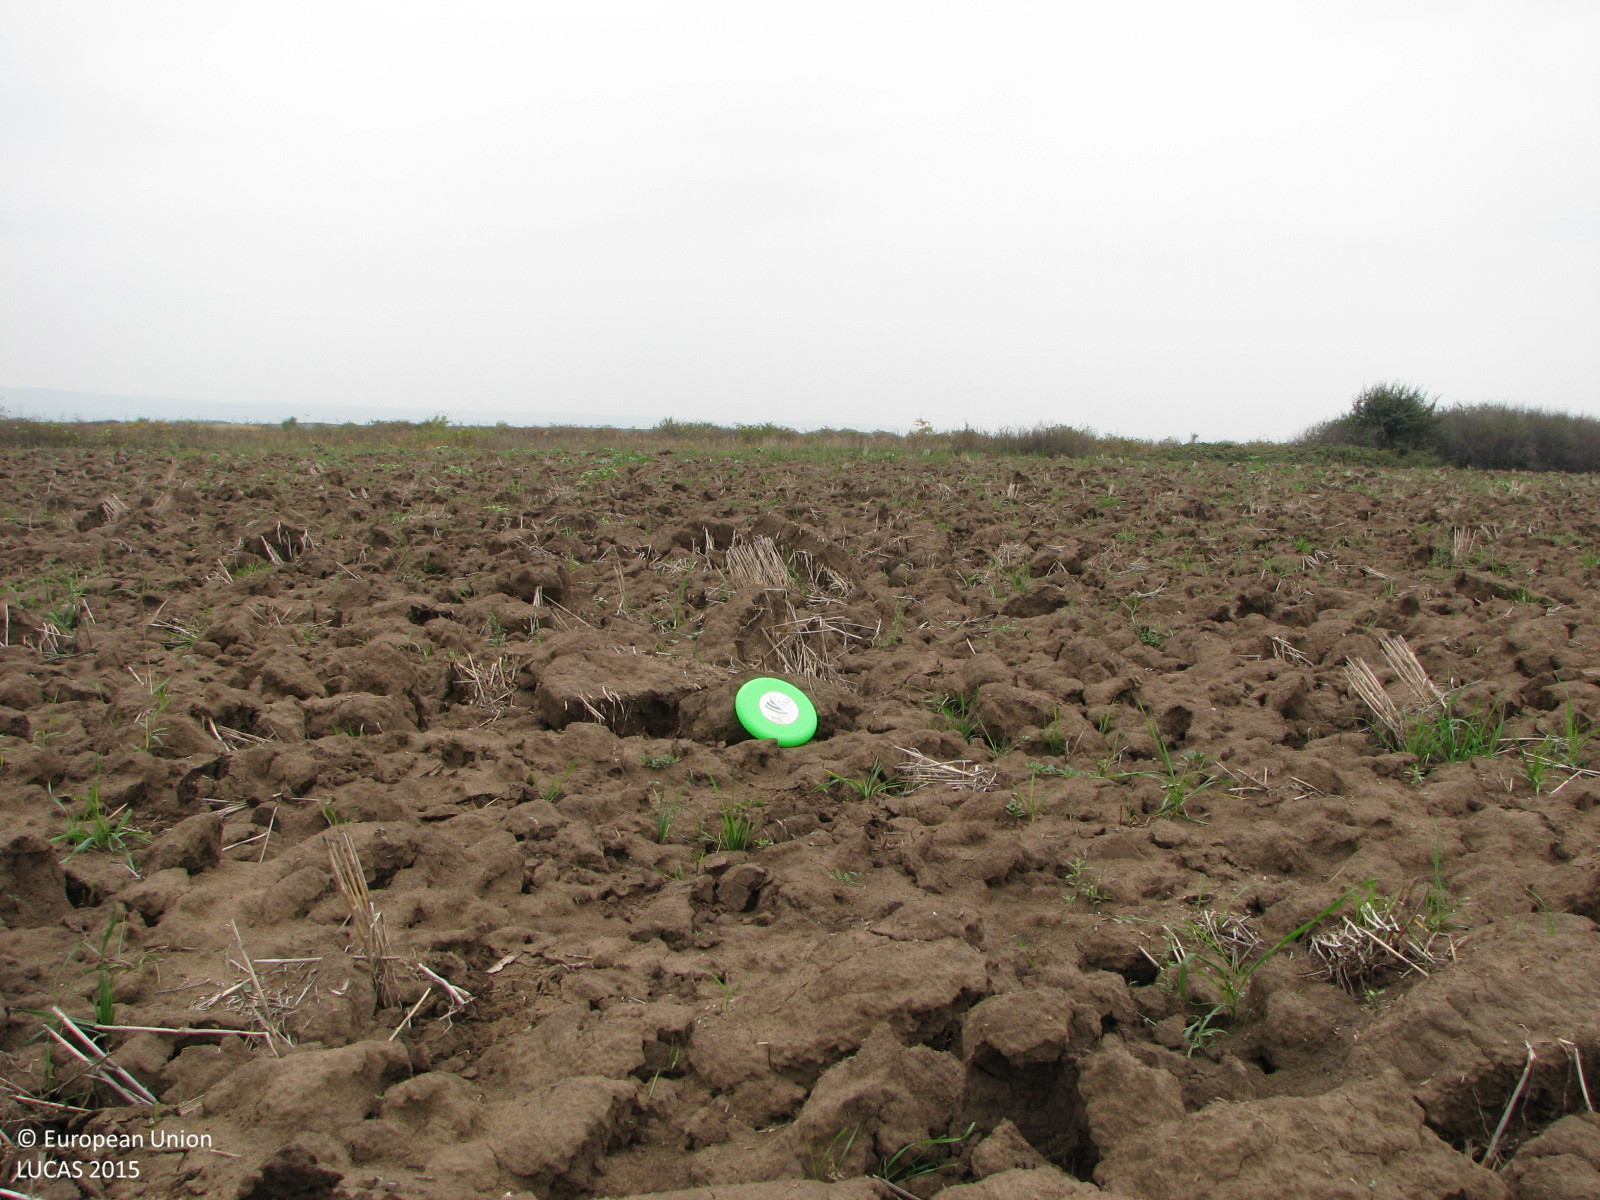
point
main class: Cropland
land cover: Common wheat
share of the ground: < 10 %
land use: Agriculture (excluding fallow land and kitchen gardens)
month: October
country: BG
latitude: 42.5896
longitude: 26.7579
